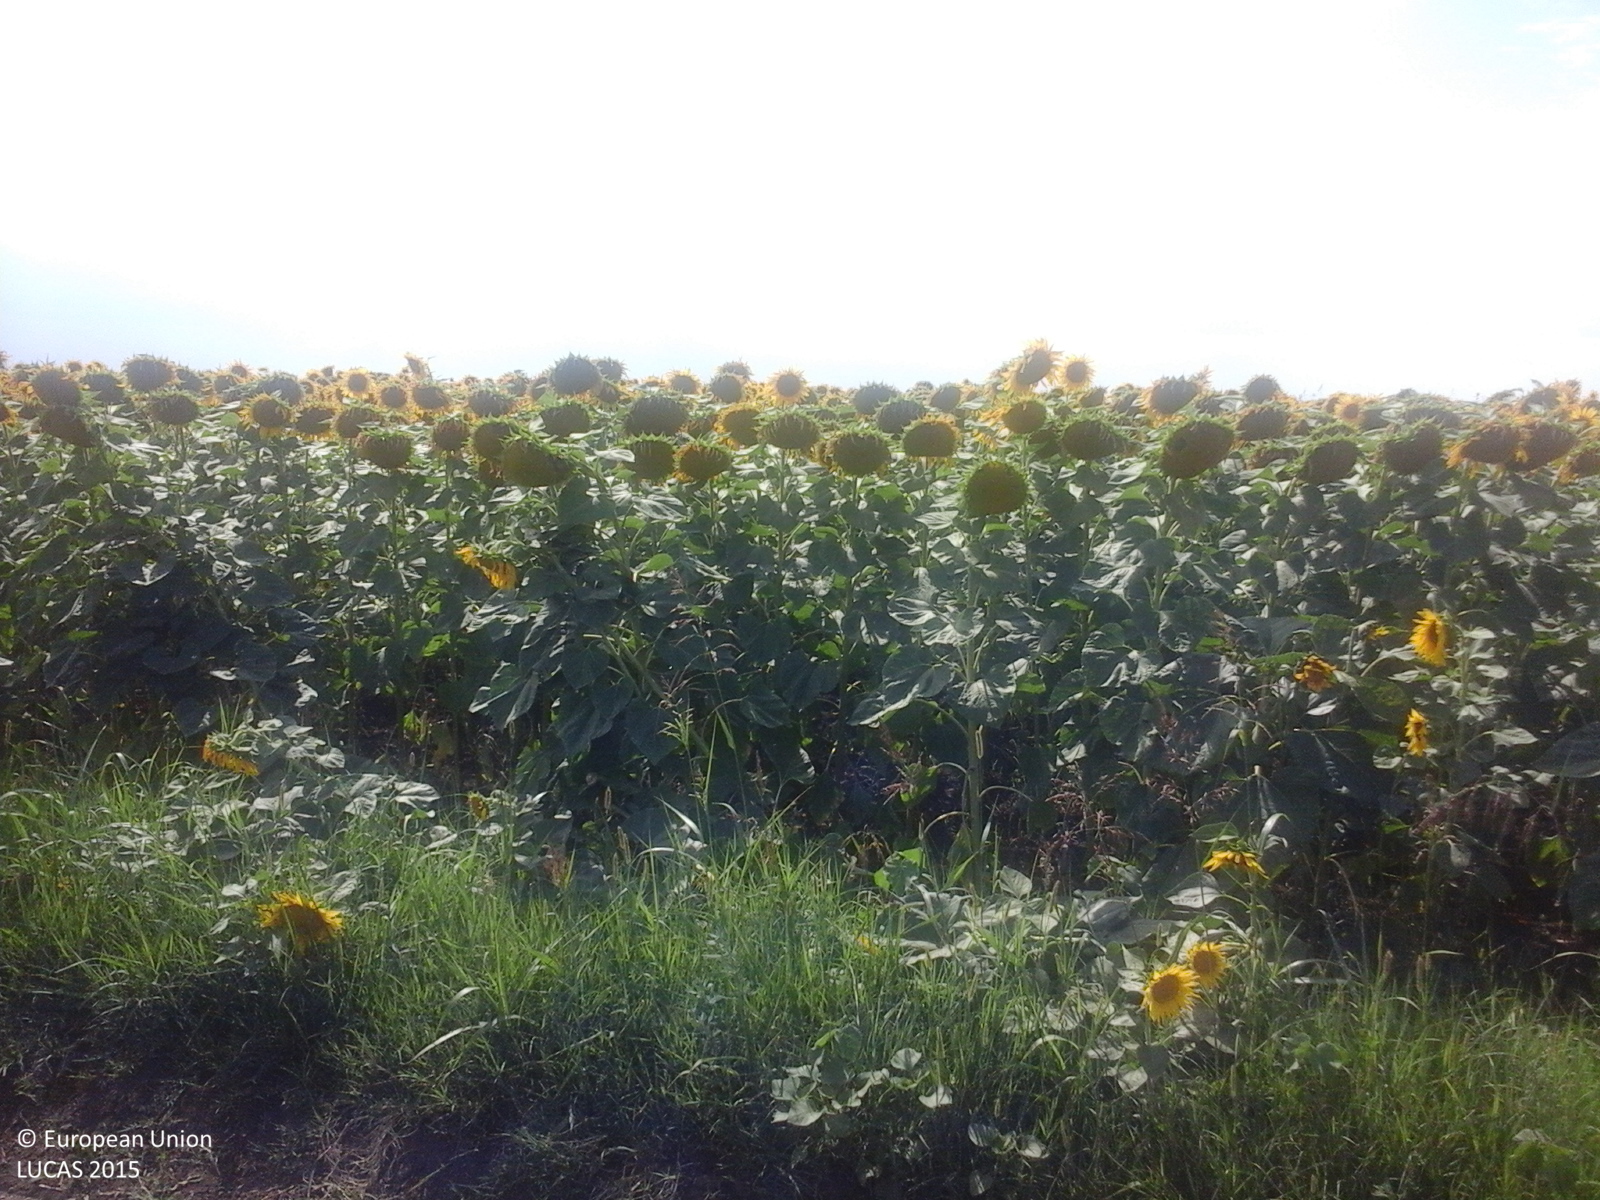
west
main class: Cropland
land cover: Sunflower
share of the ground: > 75 %
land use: Agriculture (excluding fallow land and kitchen gardens)
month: July
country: RO
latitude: 43.7909
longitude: 25.2023
